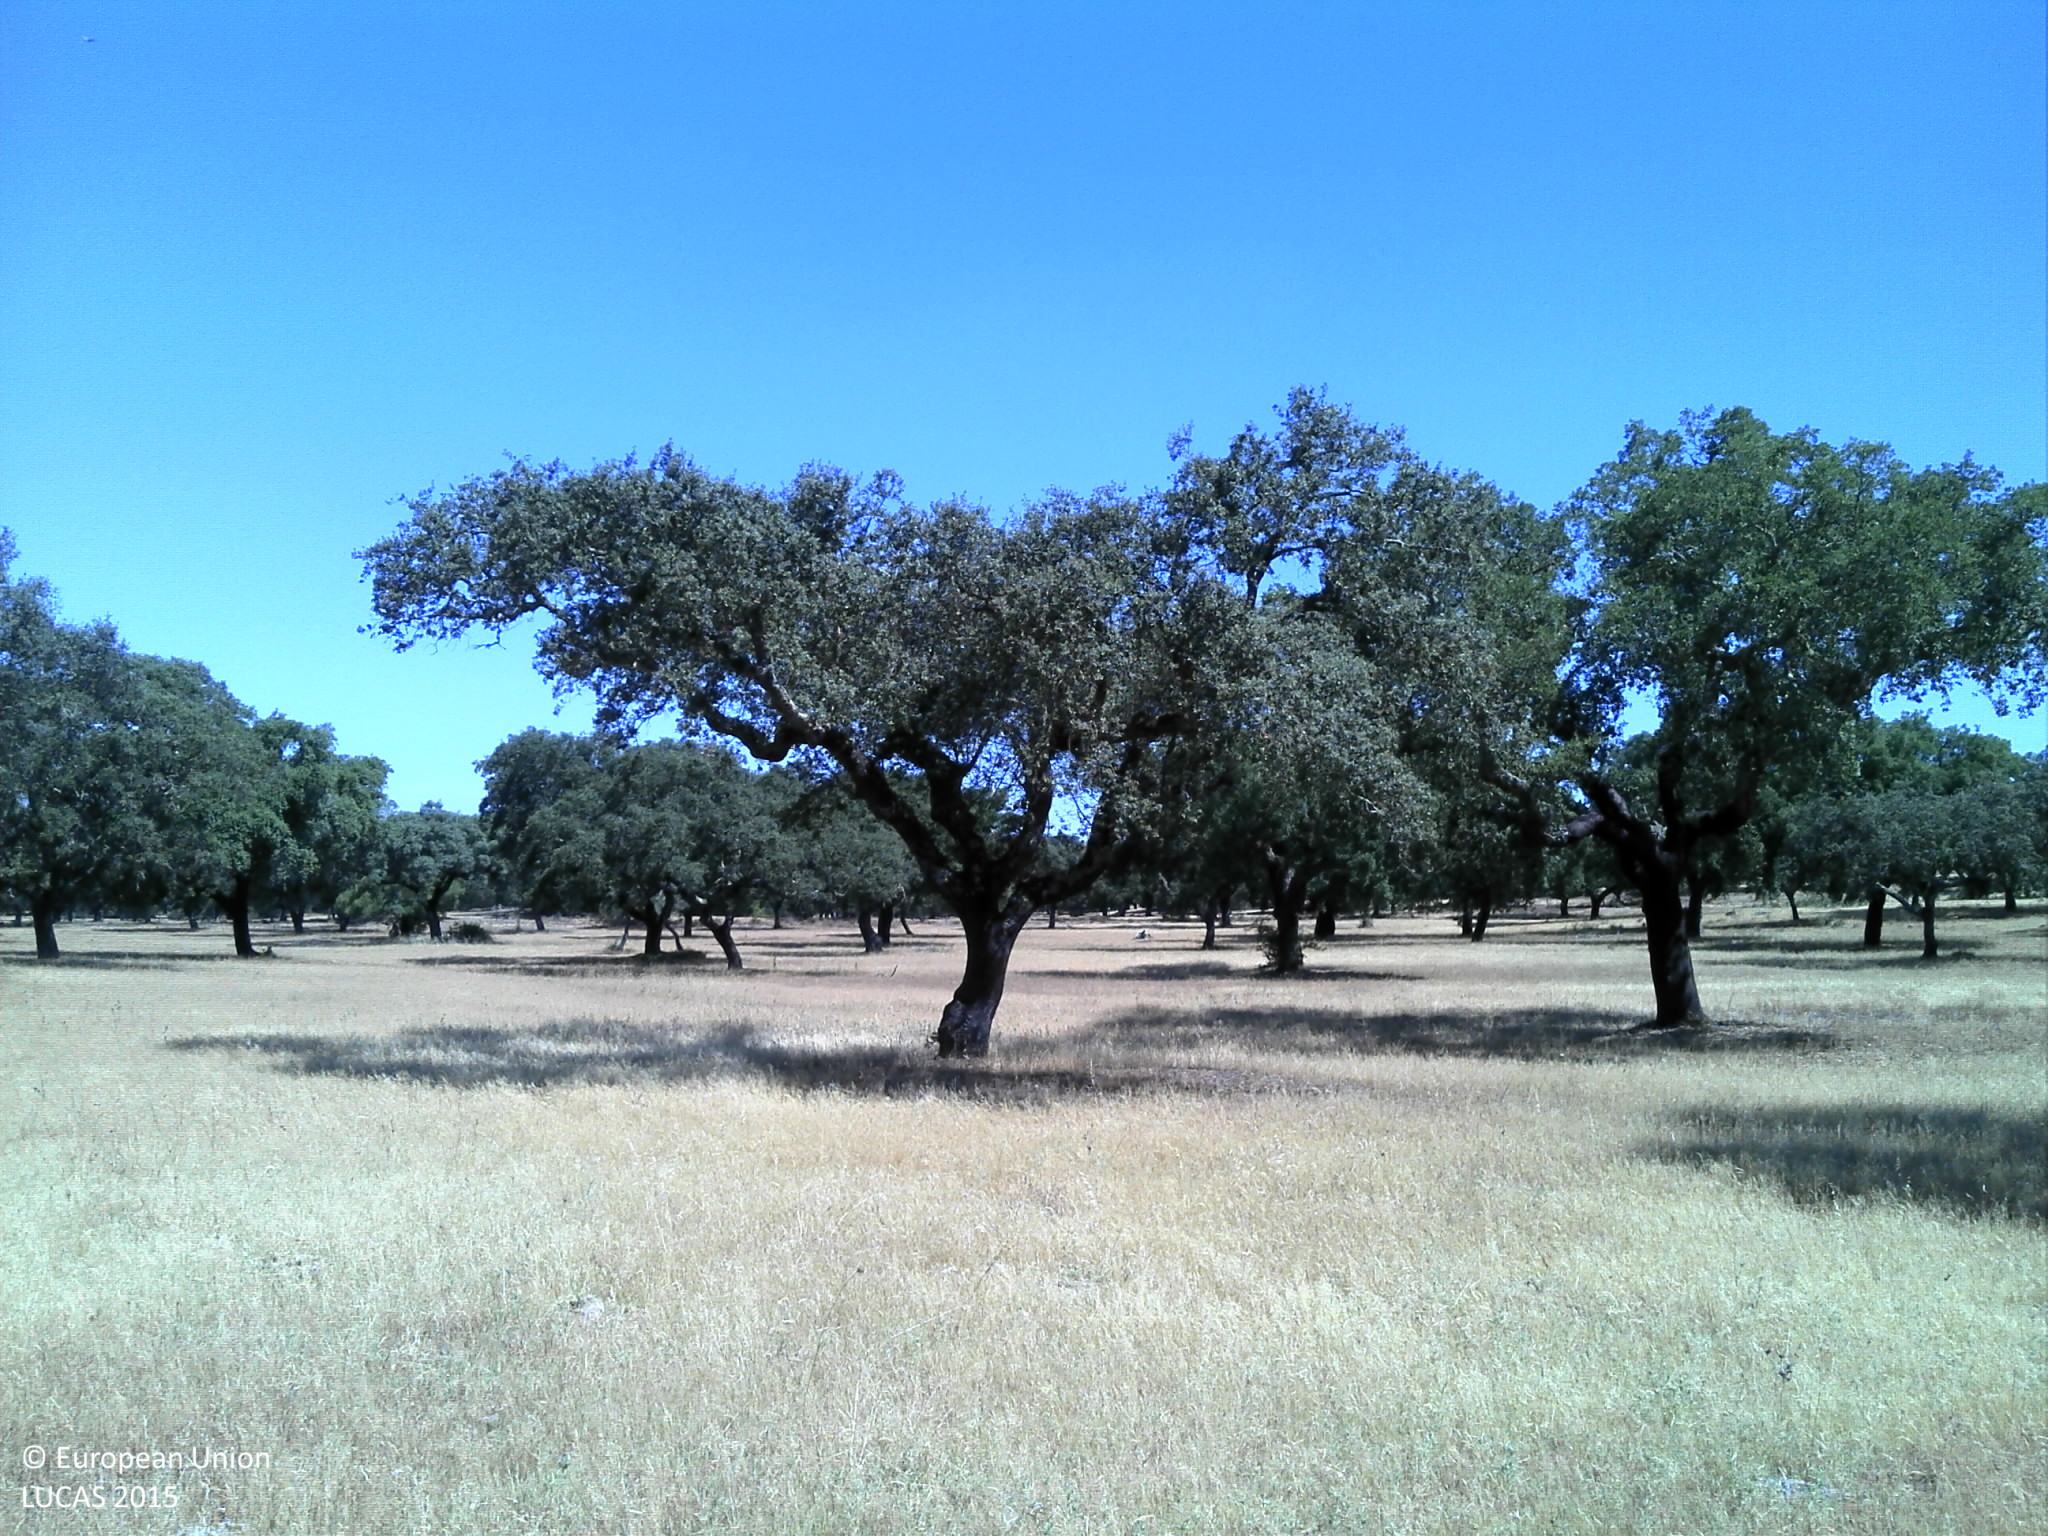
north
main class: Woodland
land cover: Broadleaved woodland
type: broadleaved evergreen forest
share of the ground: 25 - 50 %
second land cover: Grassland without tree/shrub cover
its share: 25 - 50 %
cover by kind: unconsolidated bare surface 45 %, broadleaved forest trees 30 %, herbaceous plants 25 %
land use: Forestry
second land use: Agriculture (excluding fallow land and kitchen gardens)
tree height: > 5 m
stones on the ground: < 10 %
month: June
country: PT
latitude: 38.4192
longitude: -8.1037
